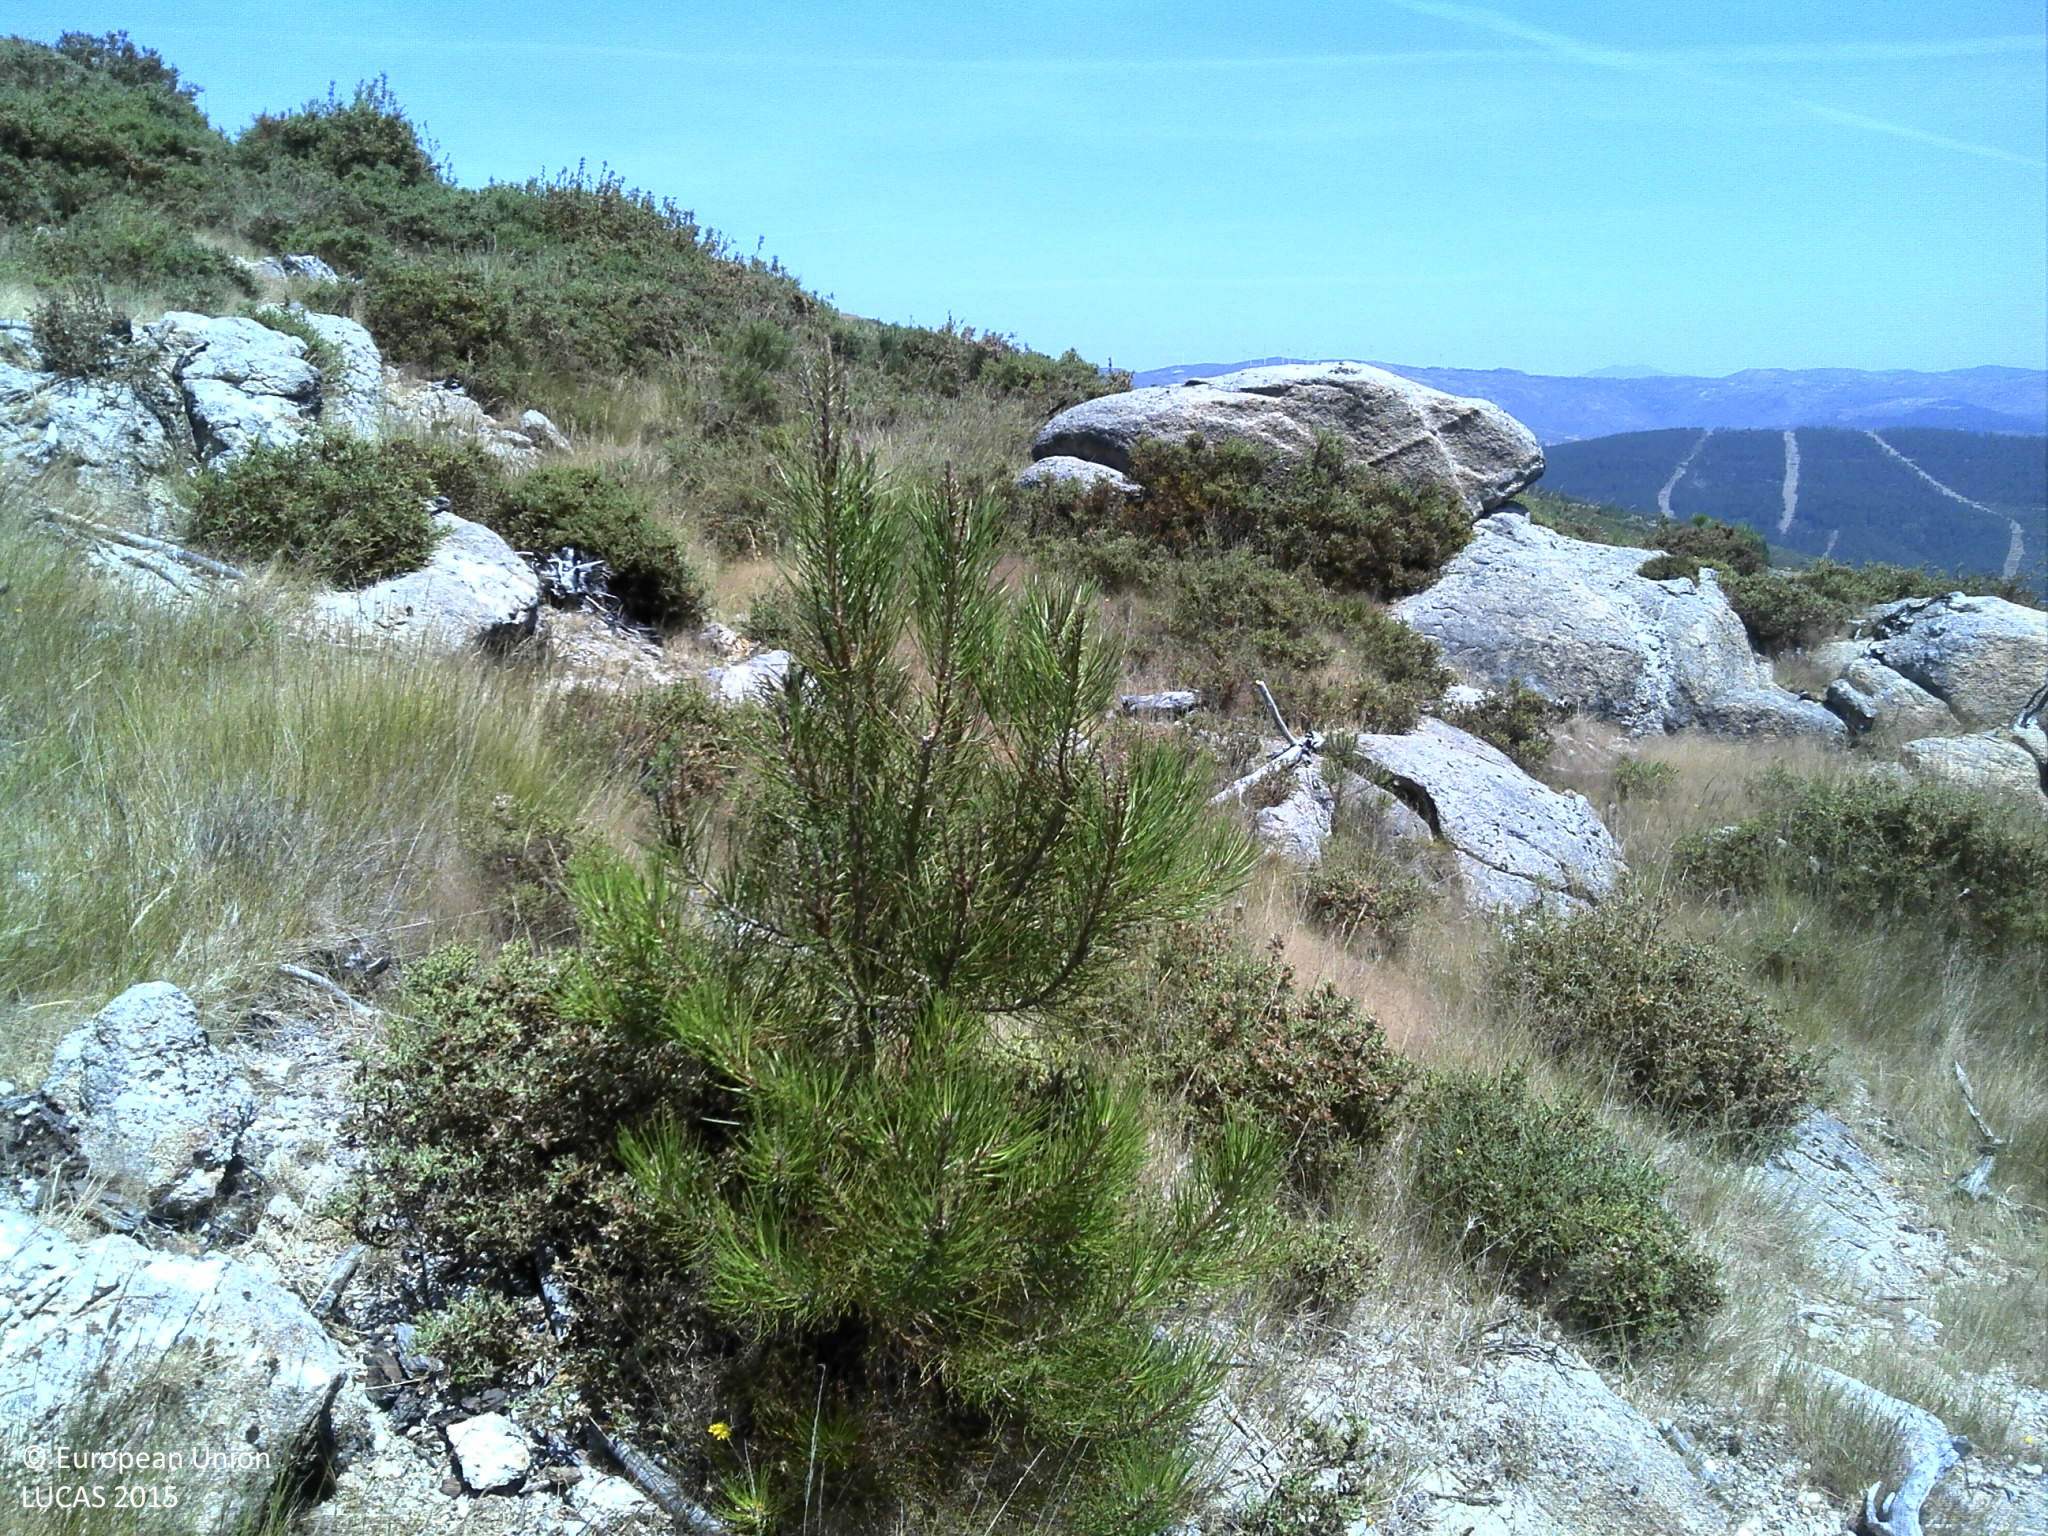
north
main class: Shrubland
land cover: Shrubland without tree cover
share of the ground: 50 - 75 %
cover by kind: shrubs 75 %, unconsolidated bare surface 20 %, consolidated bare surface 5 %
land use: Agriculture (excluding fallow land and kitchen gardens)
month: July
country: PT
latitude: 41.5830
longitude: -7.8791
